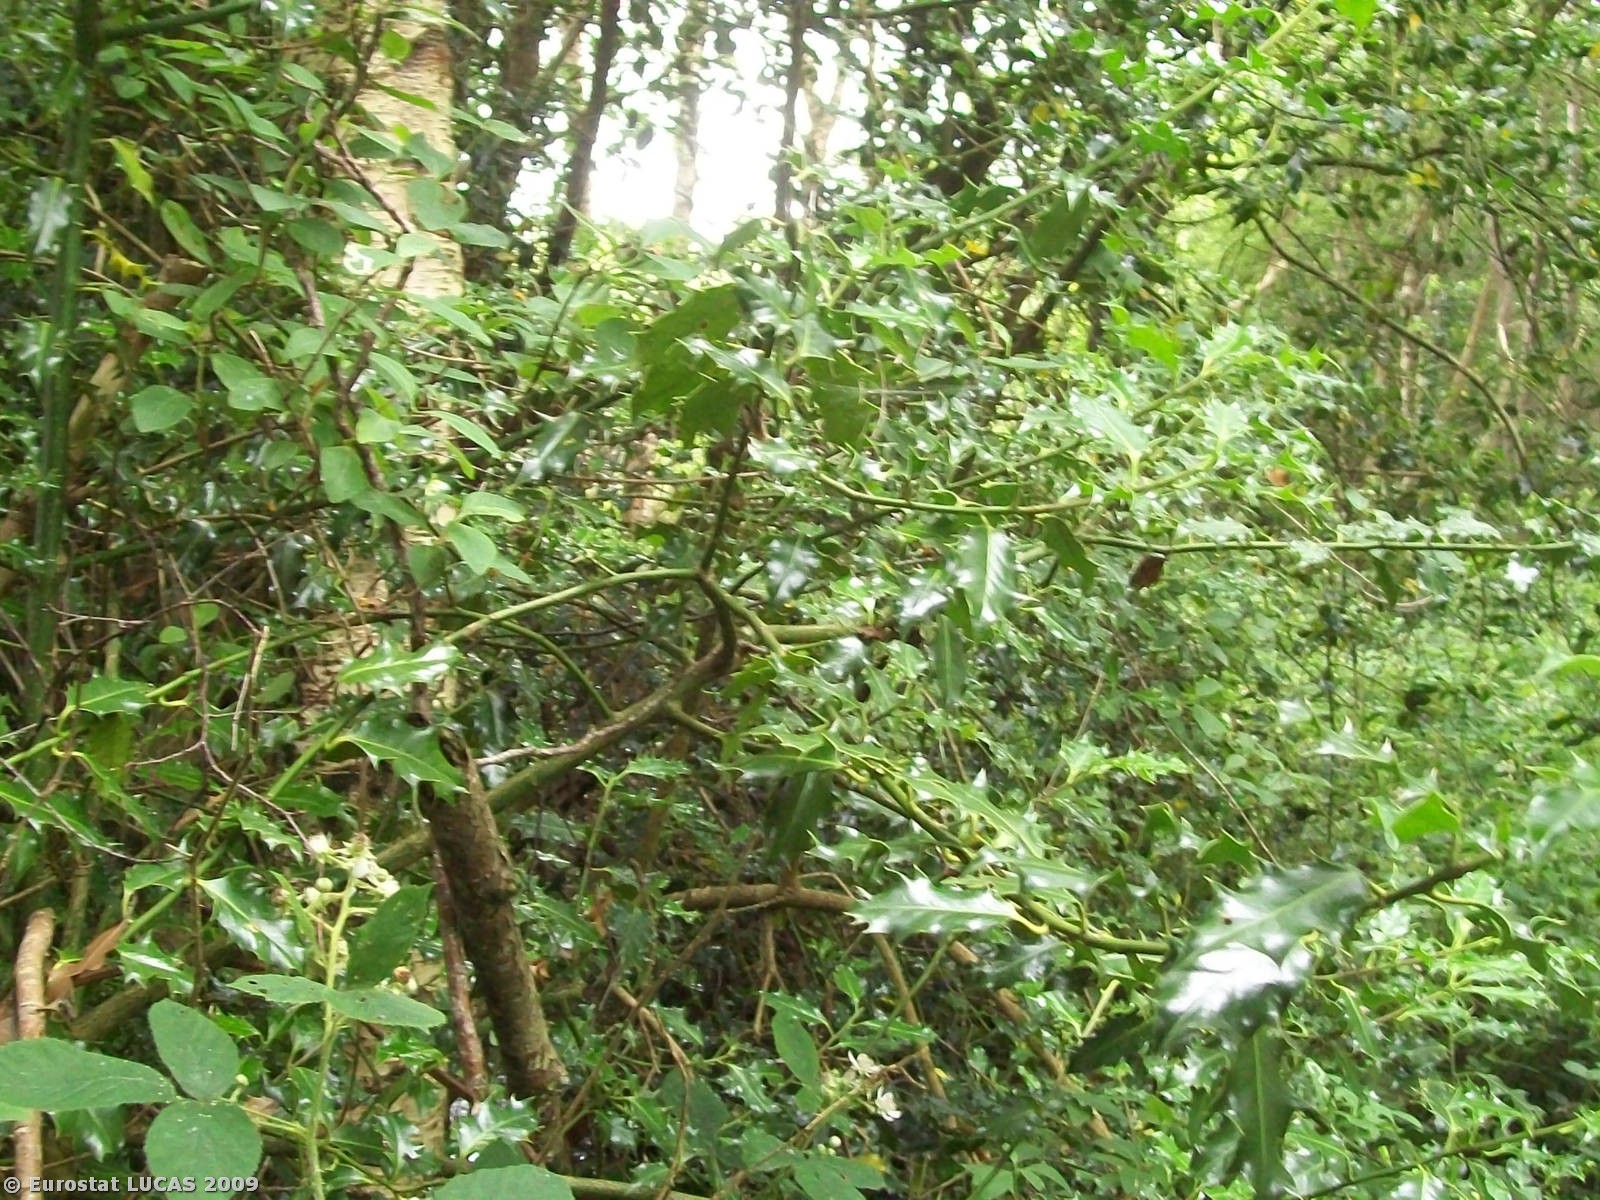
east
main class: Woodland
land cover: Broadleaved woodland
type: mesophytic deciduous forest
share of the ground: > 75 %
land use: Forestry
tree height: > 5 m
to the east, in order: Broadleaved woodland; Ditches and canals; Broadleaved woodland; Rivers and streams; Grassland without tree/shrub cover; Ditches and canals; Grassland without tree/shrub cover
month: July
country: GB
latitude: 54.7840
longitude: -6.7213
